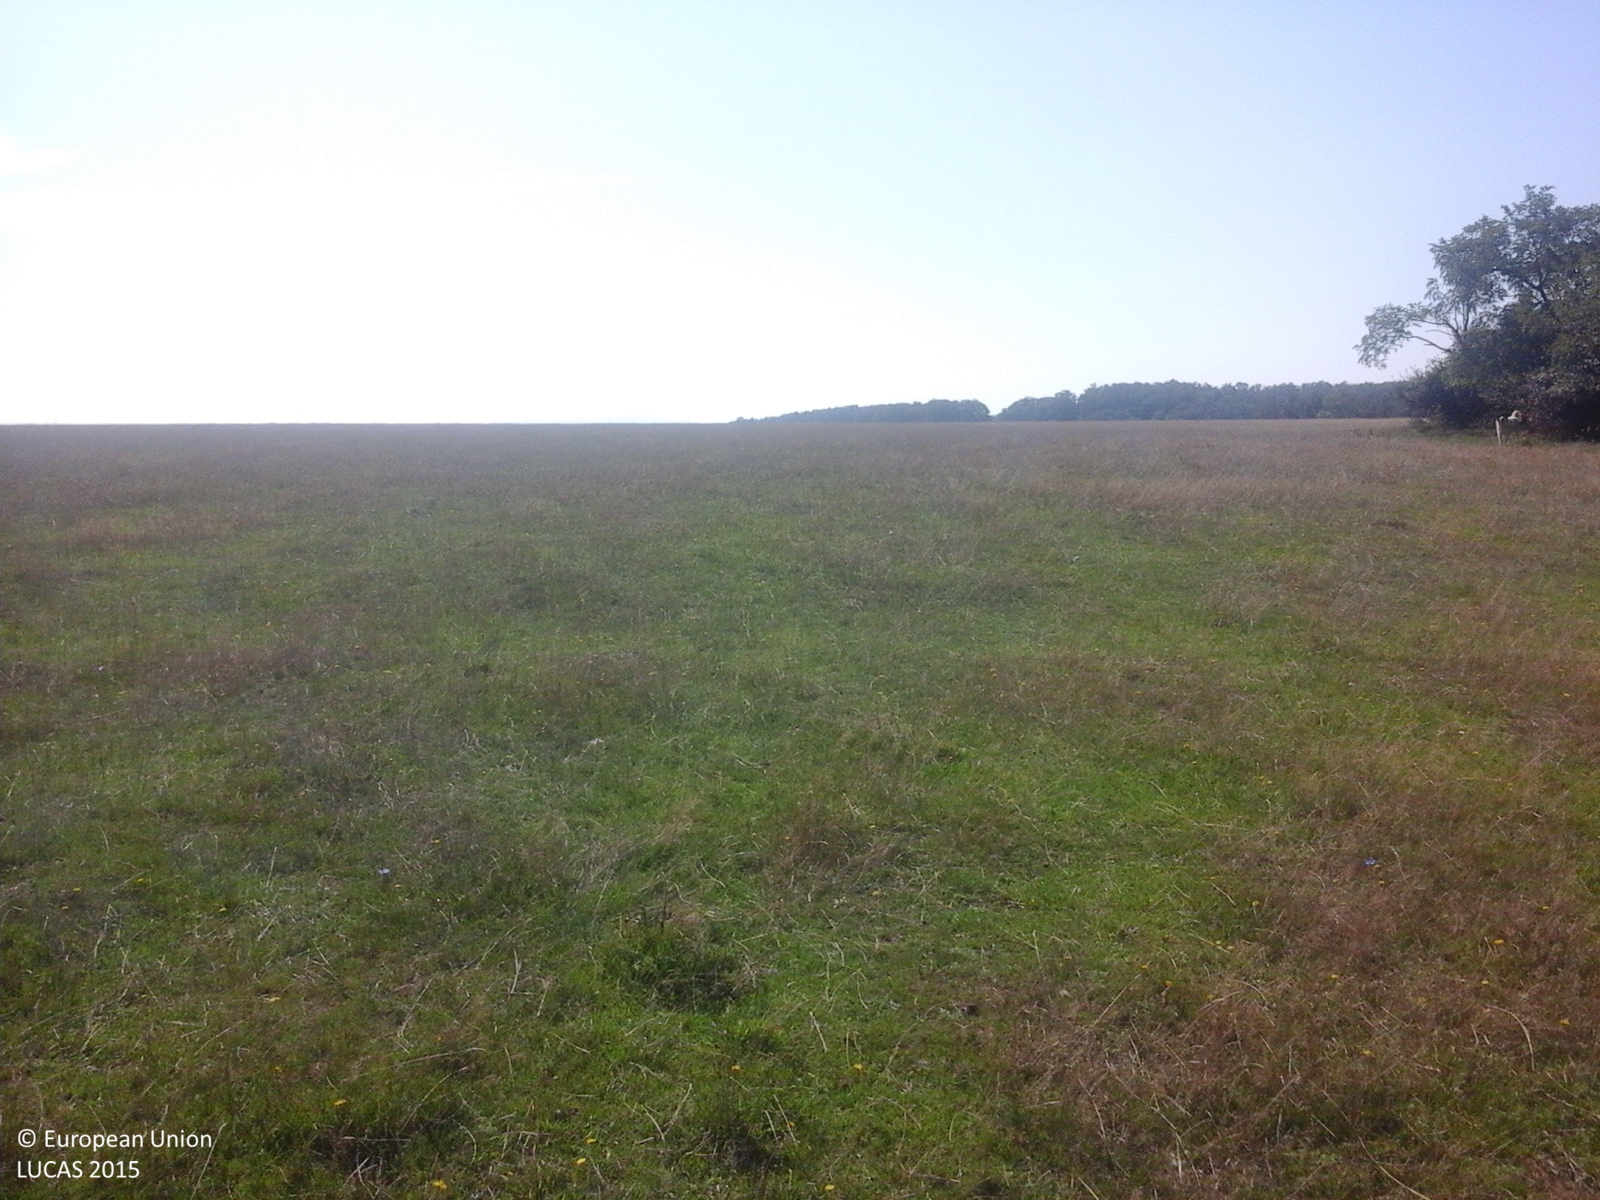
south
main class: Grassland
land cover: Grassland without tree/shrub cover
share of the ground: > 75 %
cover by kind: herbaceous plants 100 %
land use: Agriculture (excluding fallow land and kitchen gardens)
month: September
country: RO
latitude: 47.4076
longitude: 22.7425
